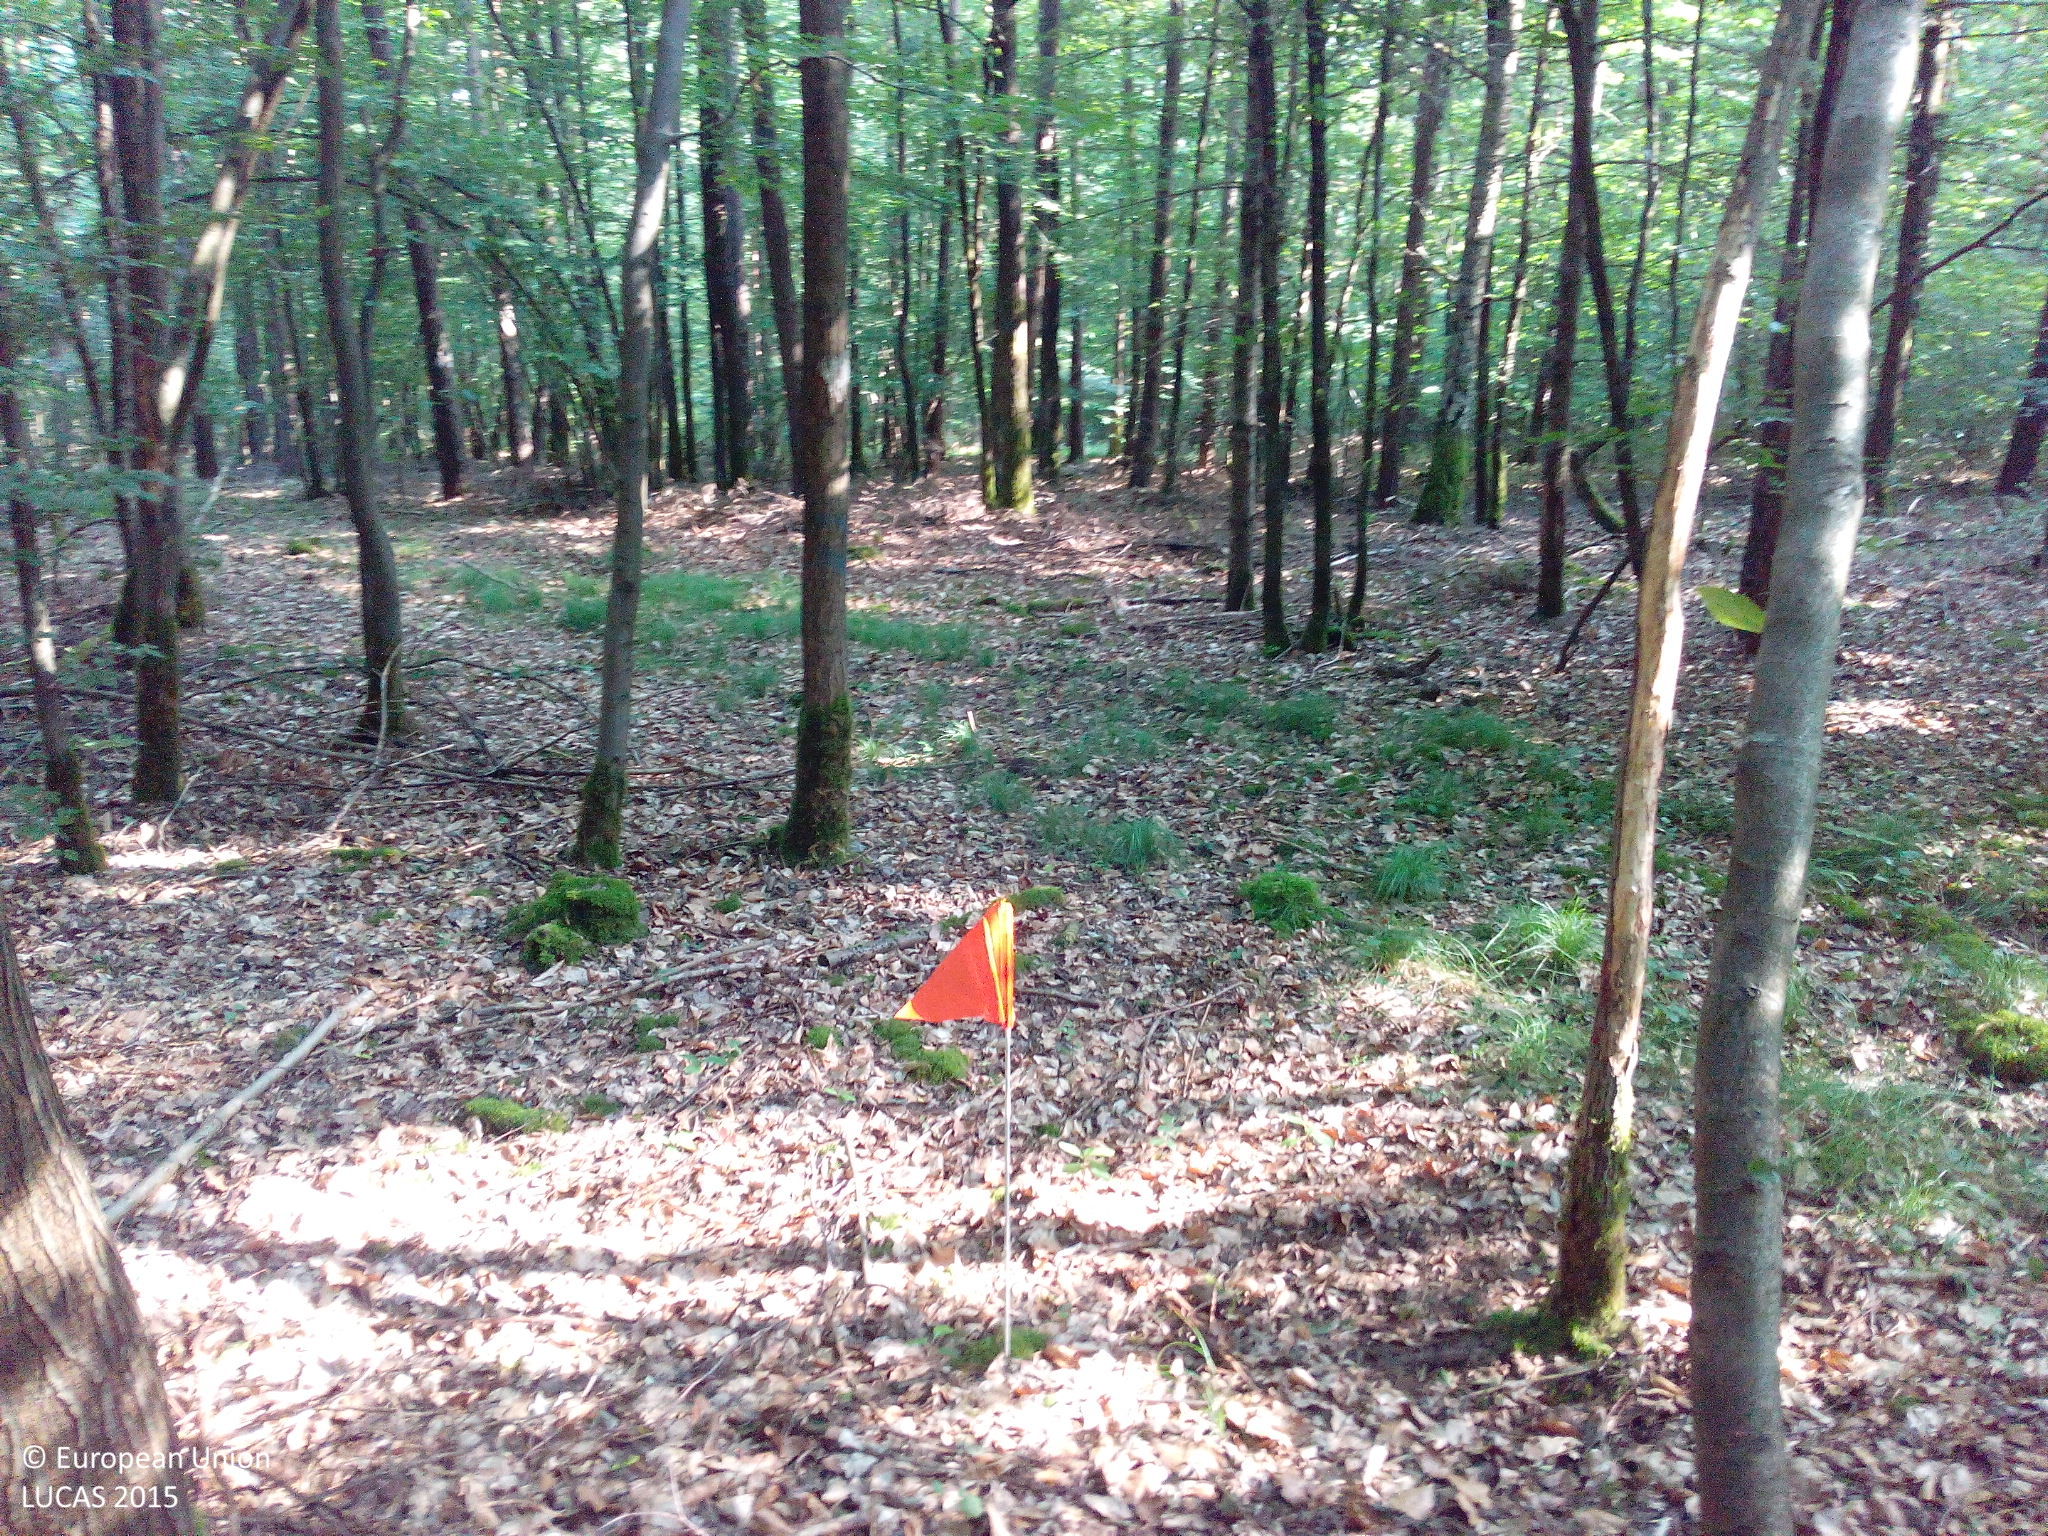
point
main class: Woodland
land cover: Pine dominated mixed woodland
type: hemiboreal forest and nemoral coniferous forest and mixed broadleaved-coniferous forest
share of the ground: > 75 %
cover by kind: broadleaved forest trees 70 %, coniferous forest trees 25 %, unconsolidated bare surface 5 %
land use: Forestry
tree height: > 5 m
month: July
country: DE
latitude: 49.8207
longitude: 10.9309
